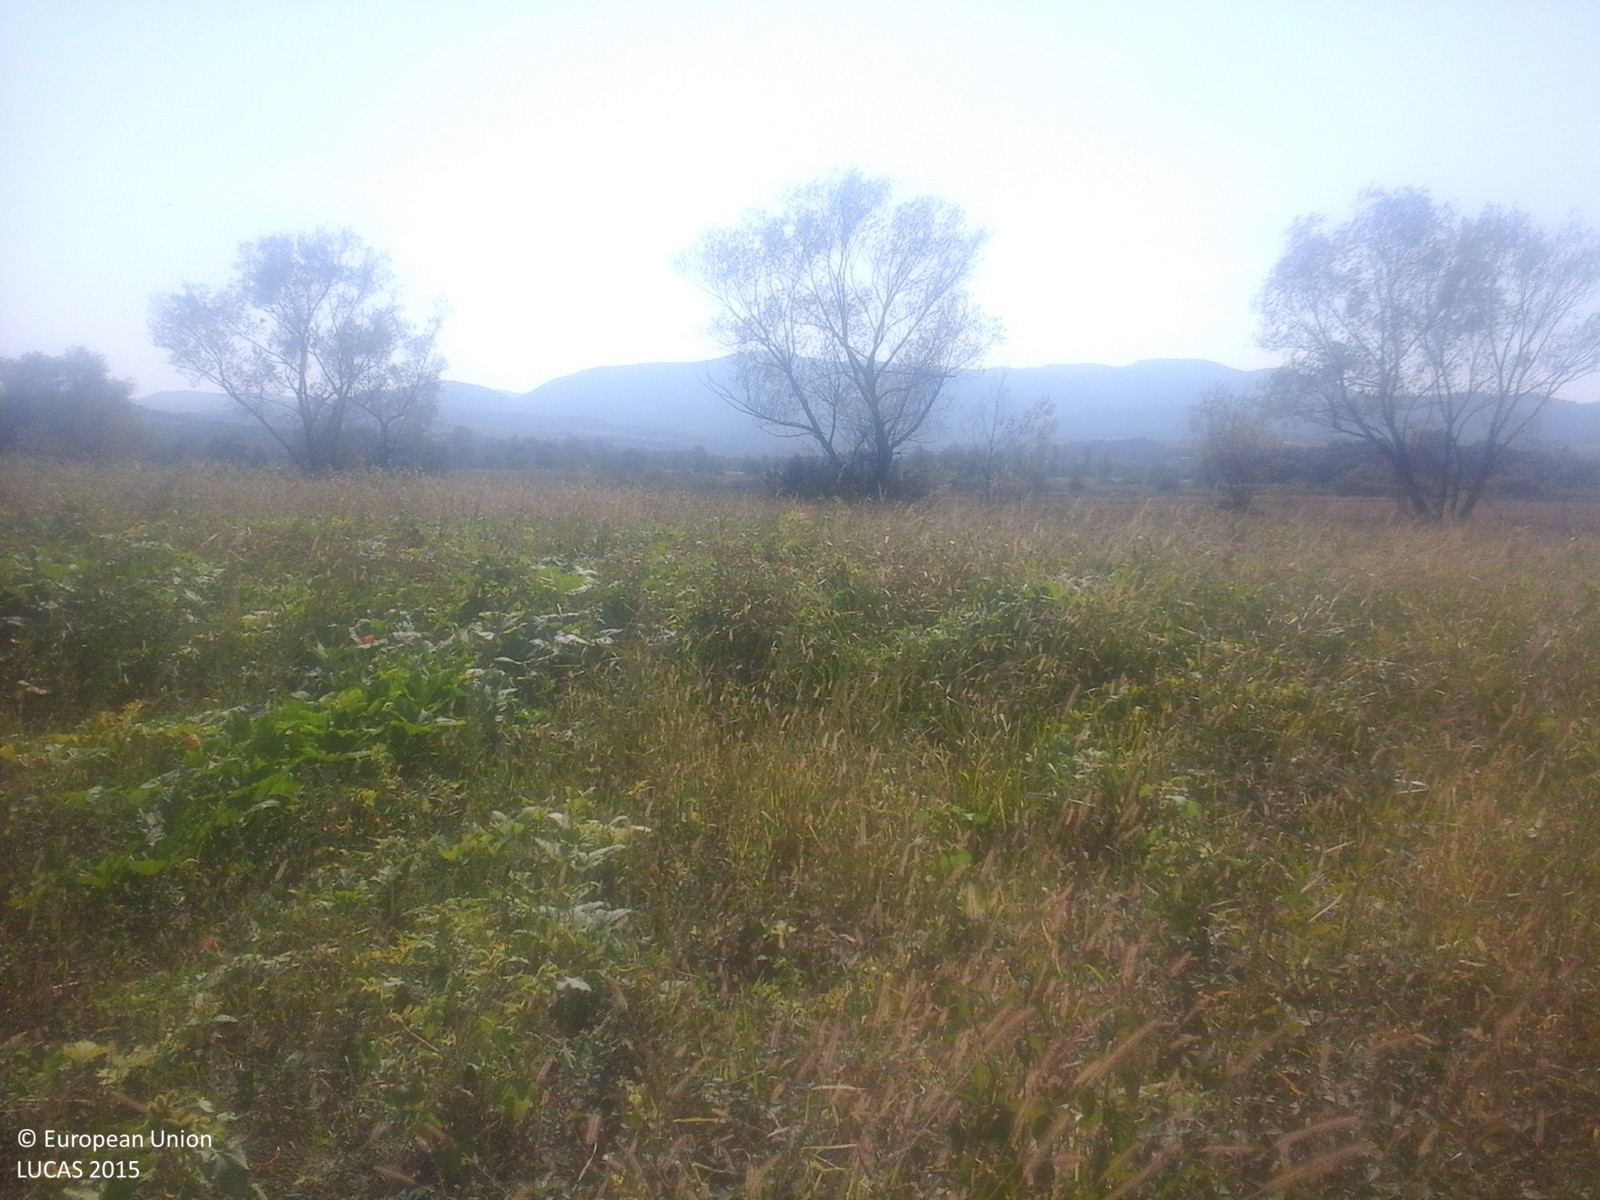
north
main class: Cropland
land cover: Maize
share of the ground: > 75 %
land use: Agriculture (excluding fallow land and kitchen gardens)
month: September
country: RO
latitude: 46.6733
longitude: 22.3243
